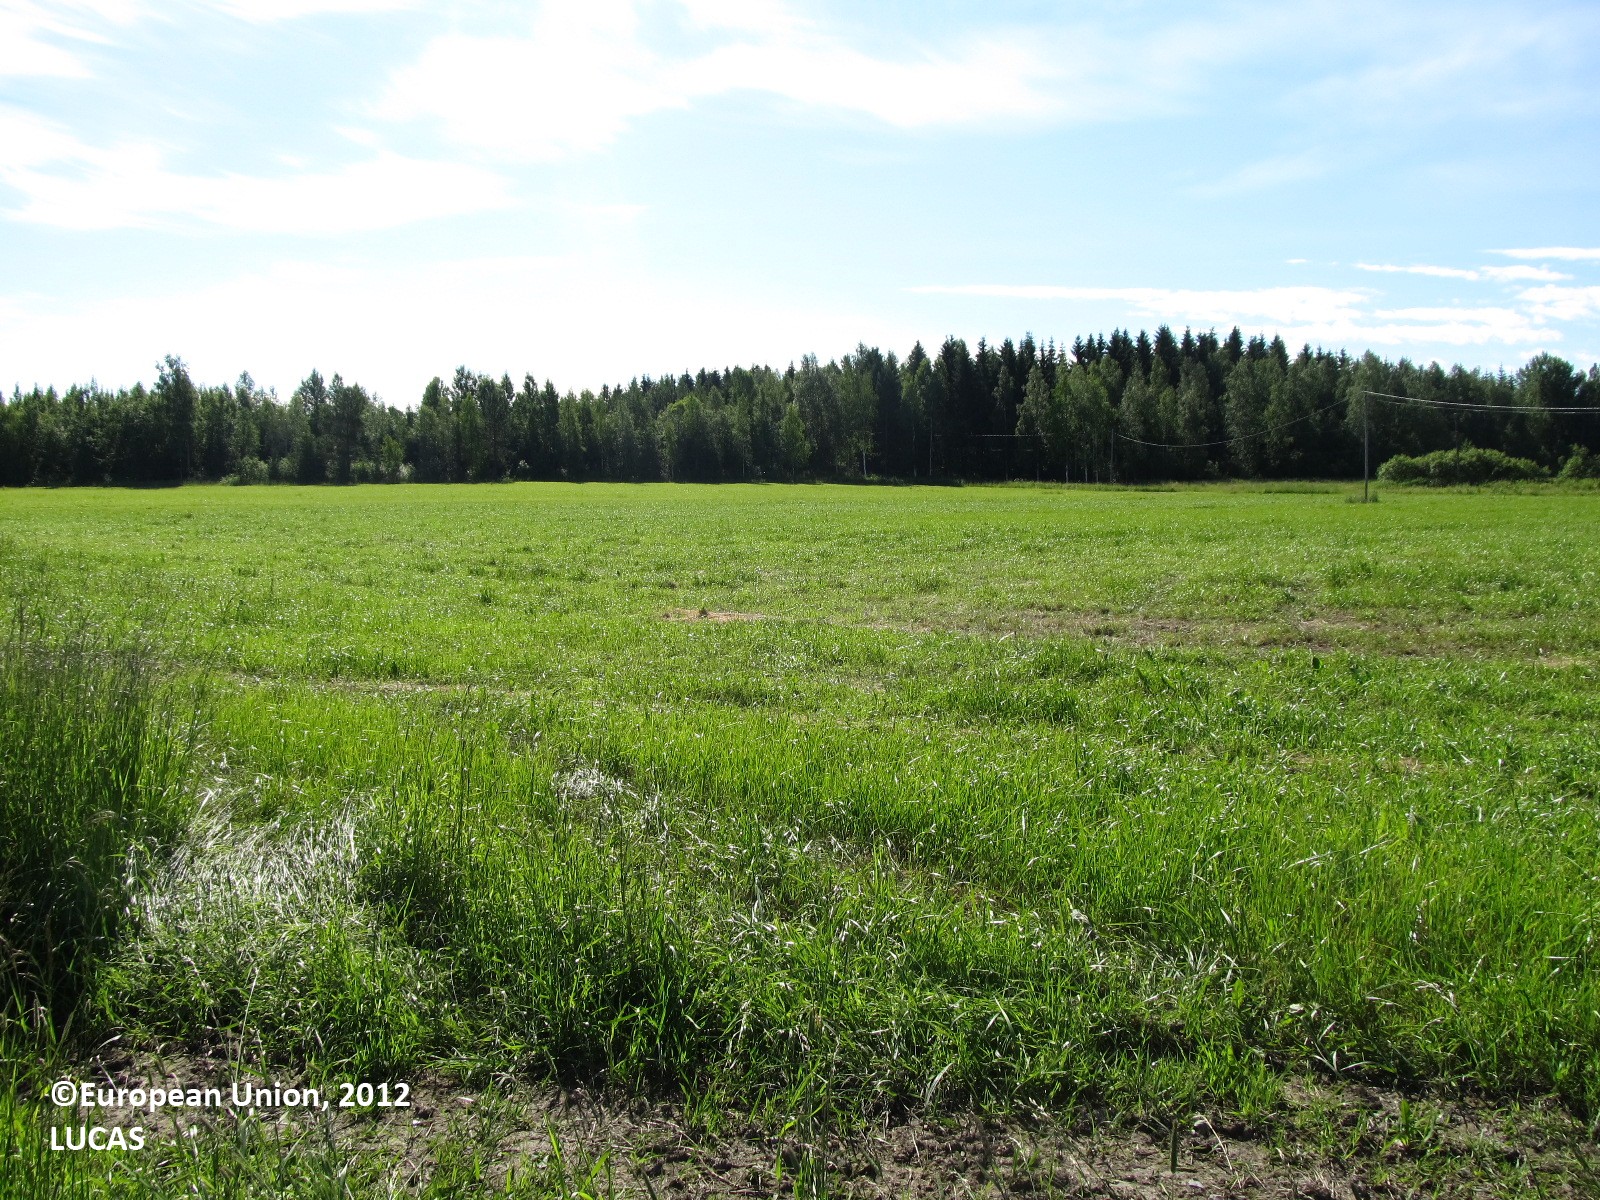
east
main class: Grassland
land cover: Grassland without tree/shrub cover
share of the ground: > 75 %
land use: Agriculture (excluding fallow land and kitchen gardens)
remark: Harvested field
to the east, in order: Grassland without tree/shrub cover; Electric lines; Ditches and canals; Grassland without tree/shrub cover; Broadleaved woodland
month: July
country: FI
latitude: 62.6320
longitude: 29.1576
